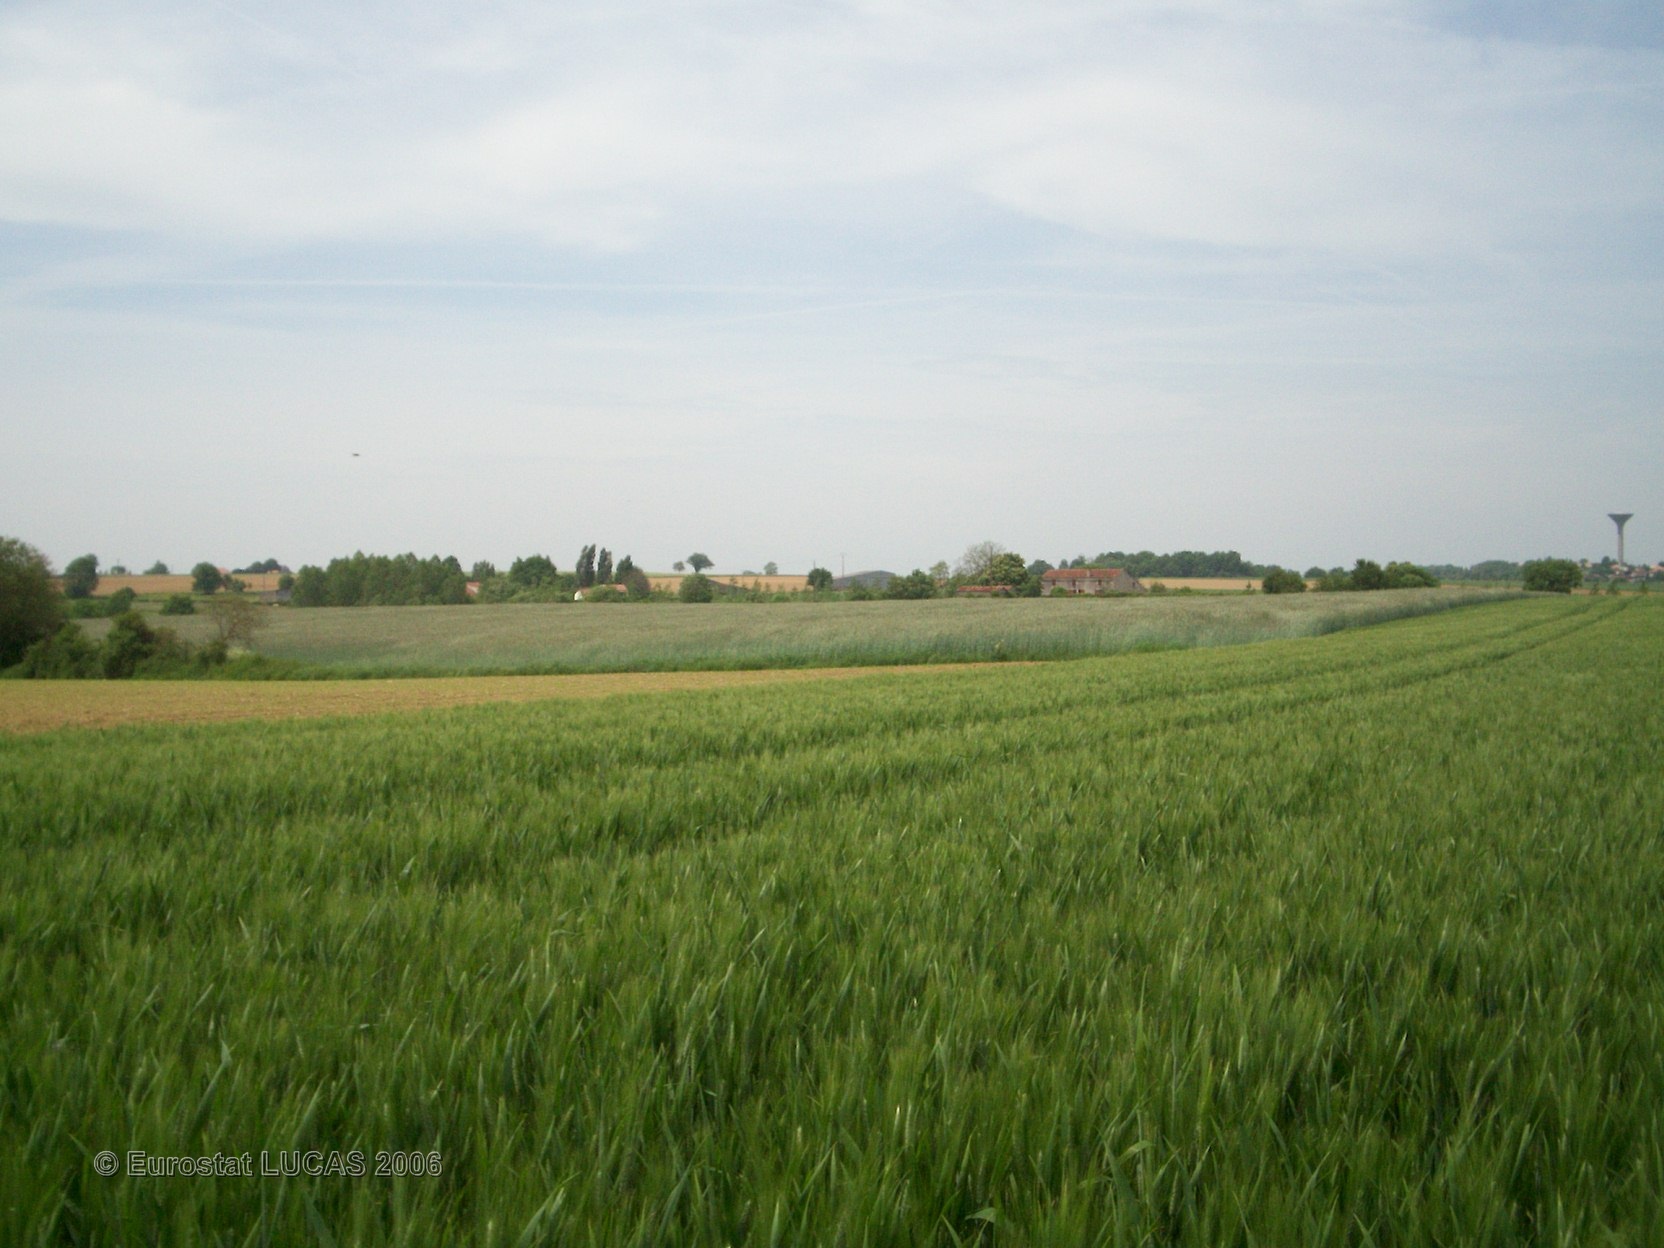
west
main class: Cropland
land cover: Barley
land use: Agriculture (excluding fallow land and kitchen gardens)
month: May
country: FR
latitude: 46.6678
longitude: -0.8666
